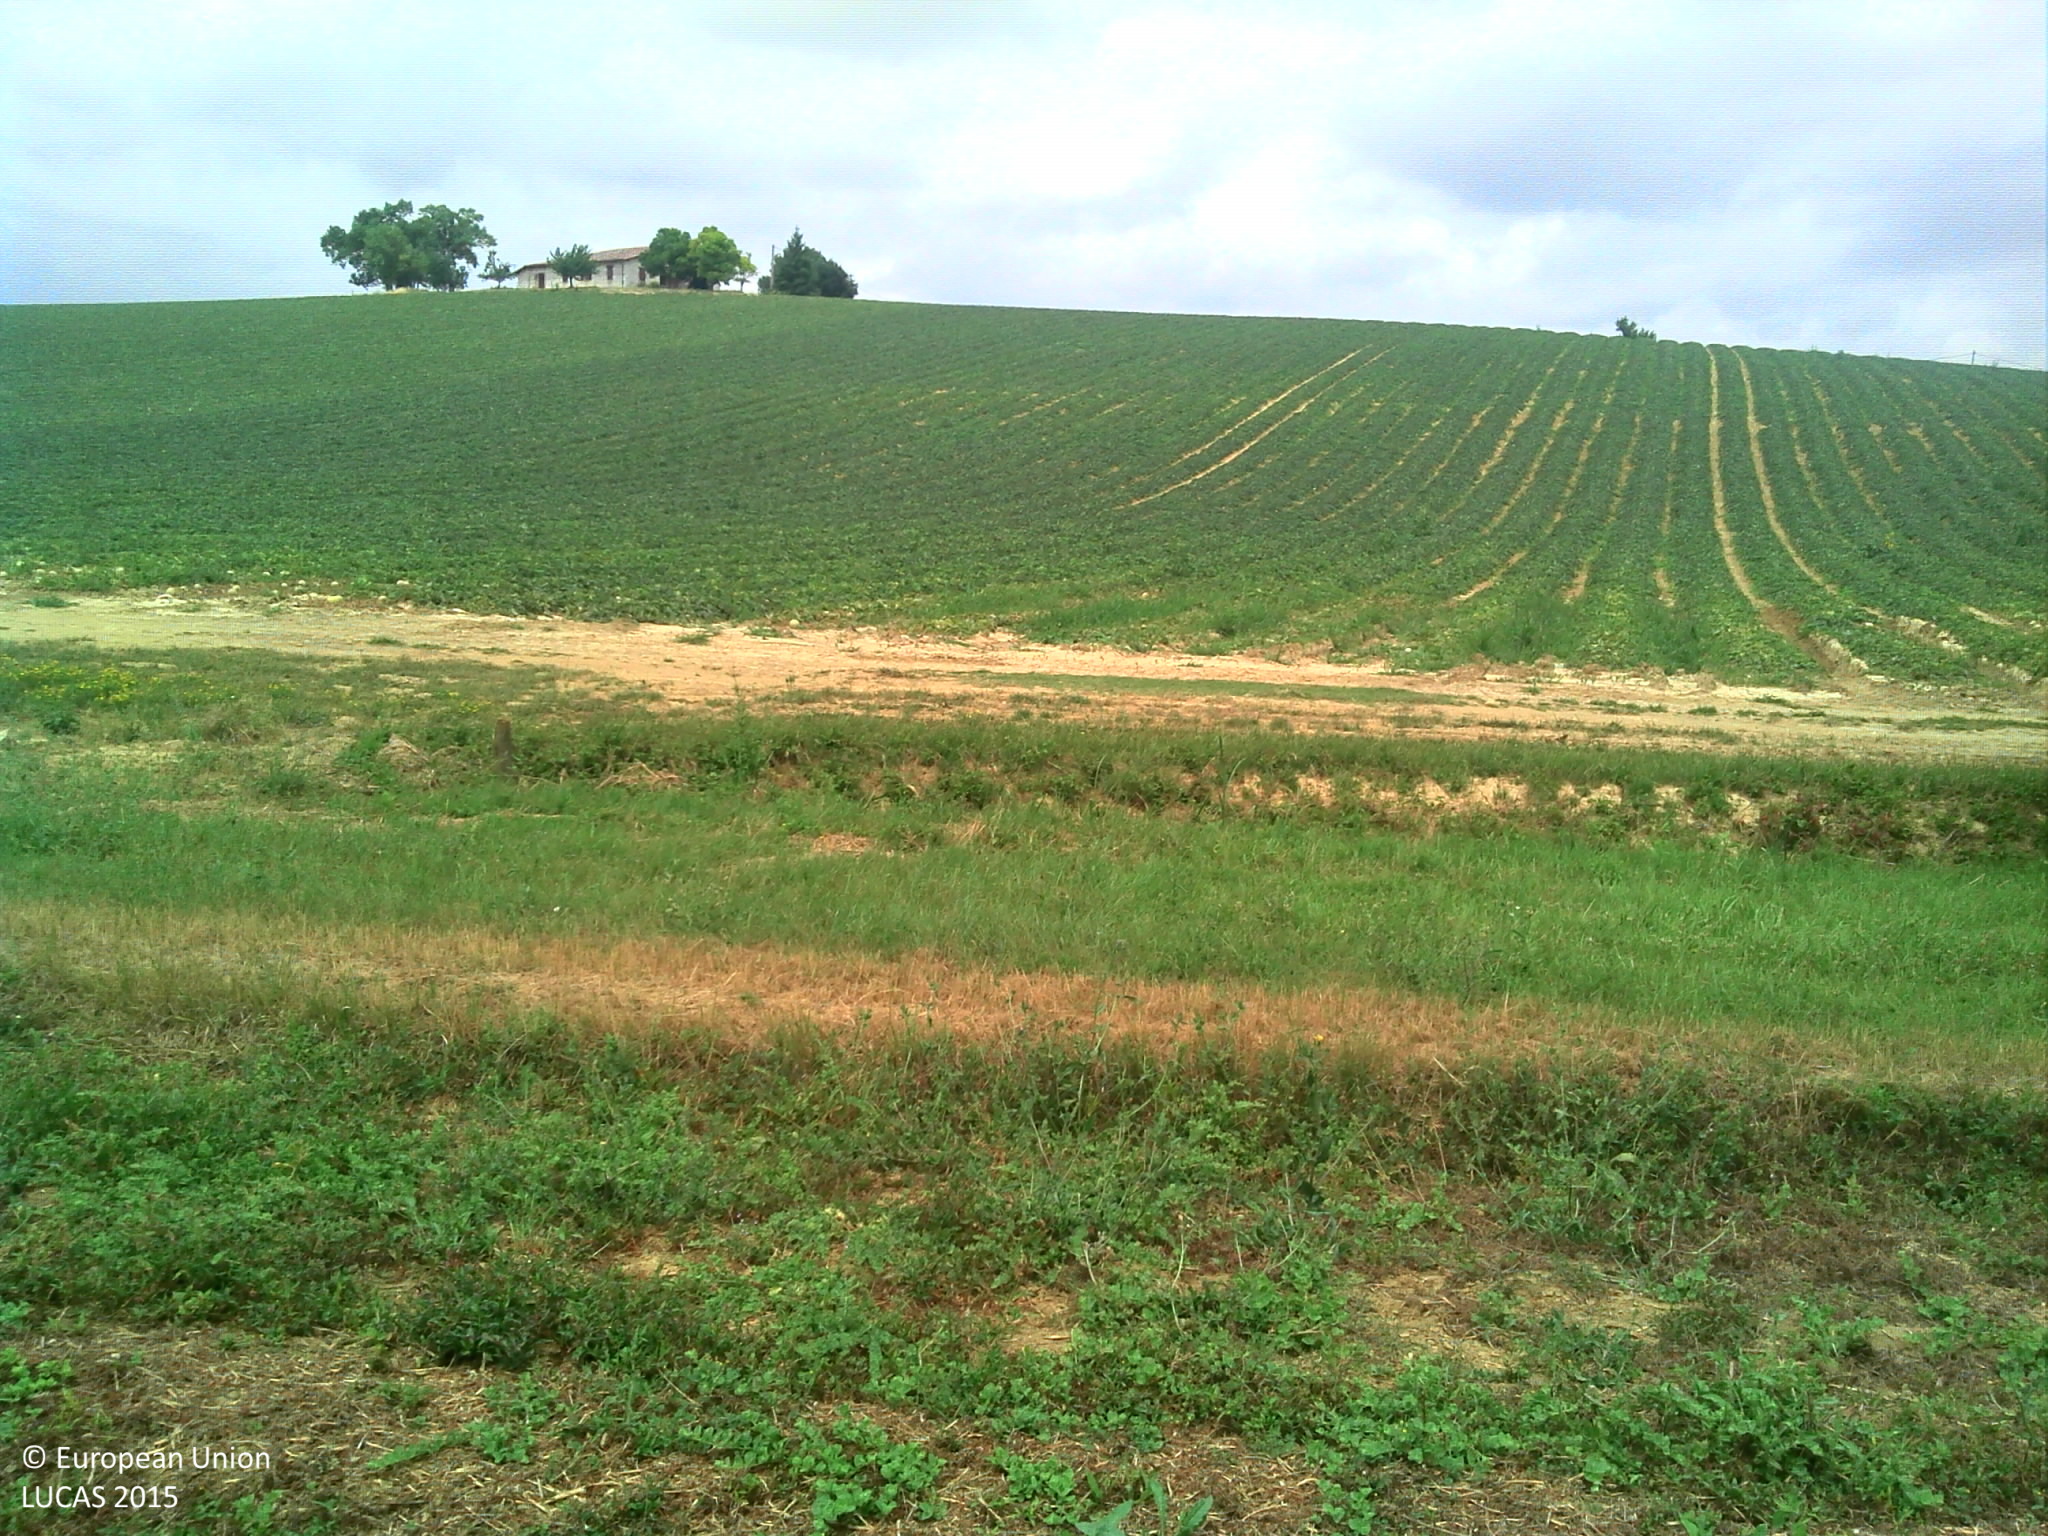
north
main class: Cropland
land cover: Temporary grasslands
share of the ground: > 75 %
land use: Agriculture (excluding fallow land and kitchen gardens)
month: July
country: FR
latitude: 43.8640
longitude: 0.9529
